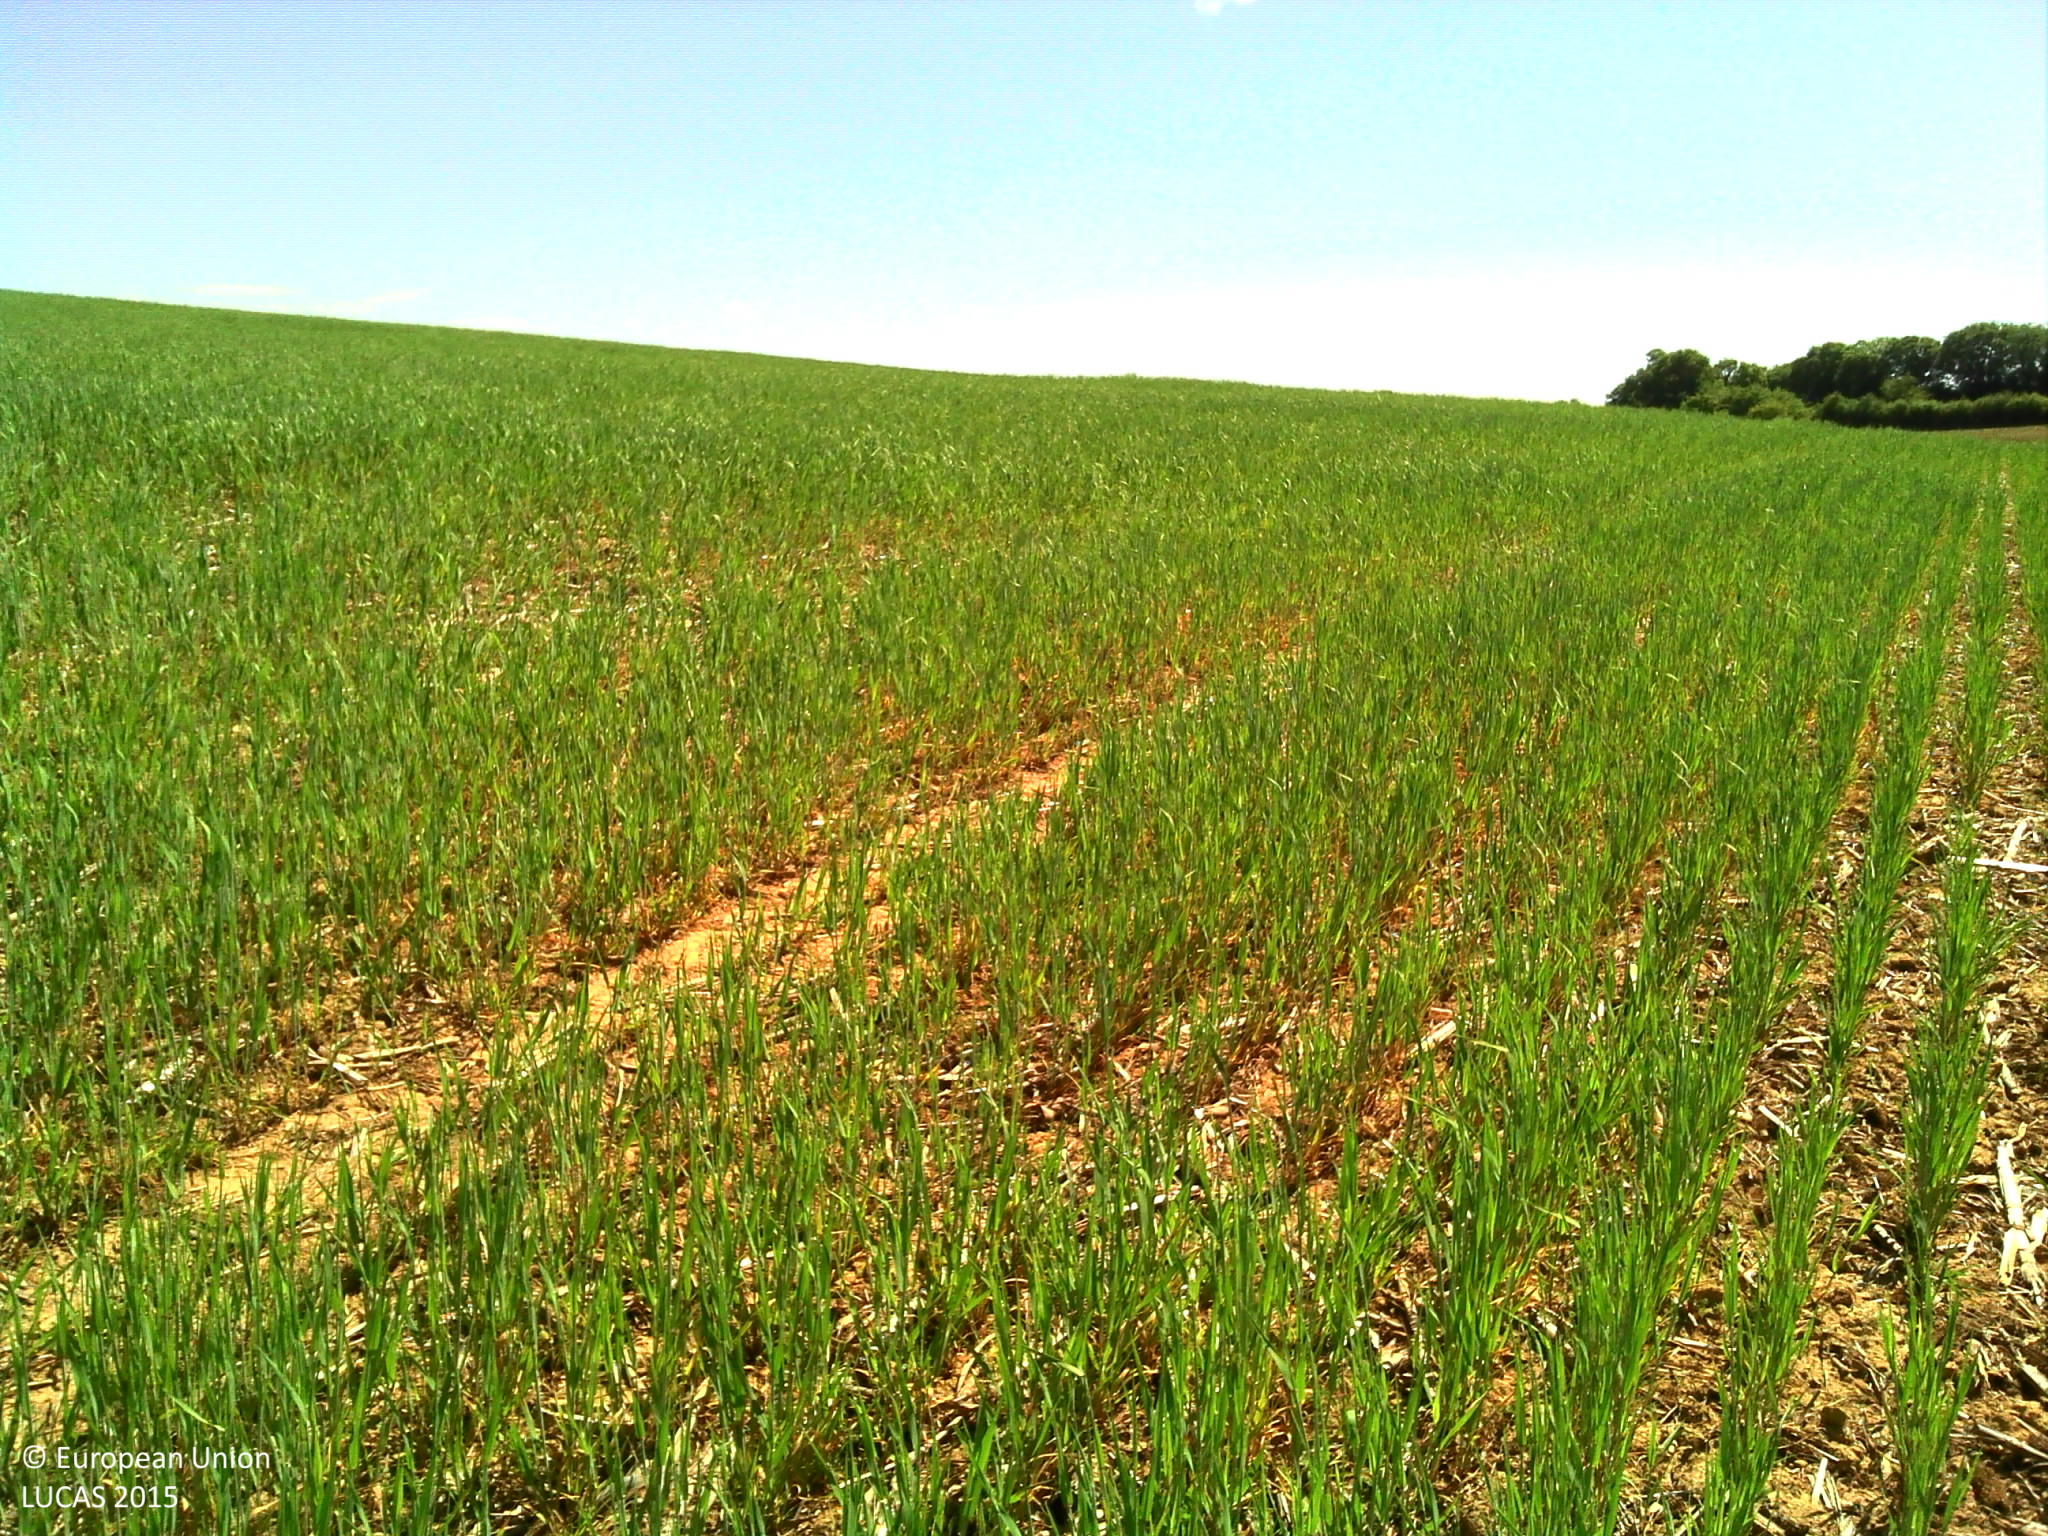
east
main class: Cropland
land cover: Barley
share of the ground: > 75 %
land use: Agriculture (excluding fallow land and kitchen gardens)
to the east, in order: Barley; Grassland without tree/shrub cover
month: June
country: FR
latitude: 47.0192
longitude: 2.9042
